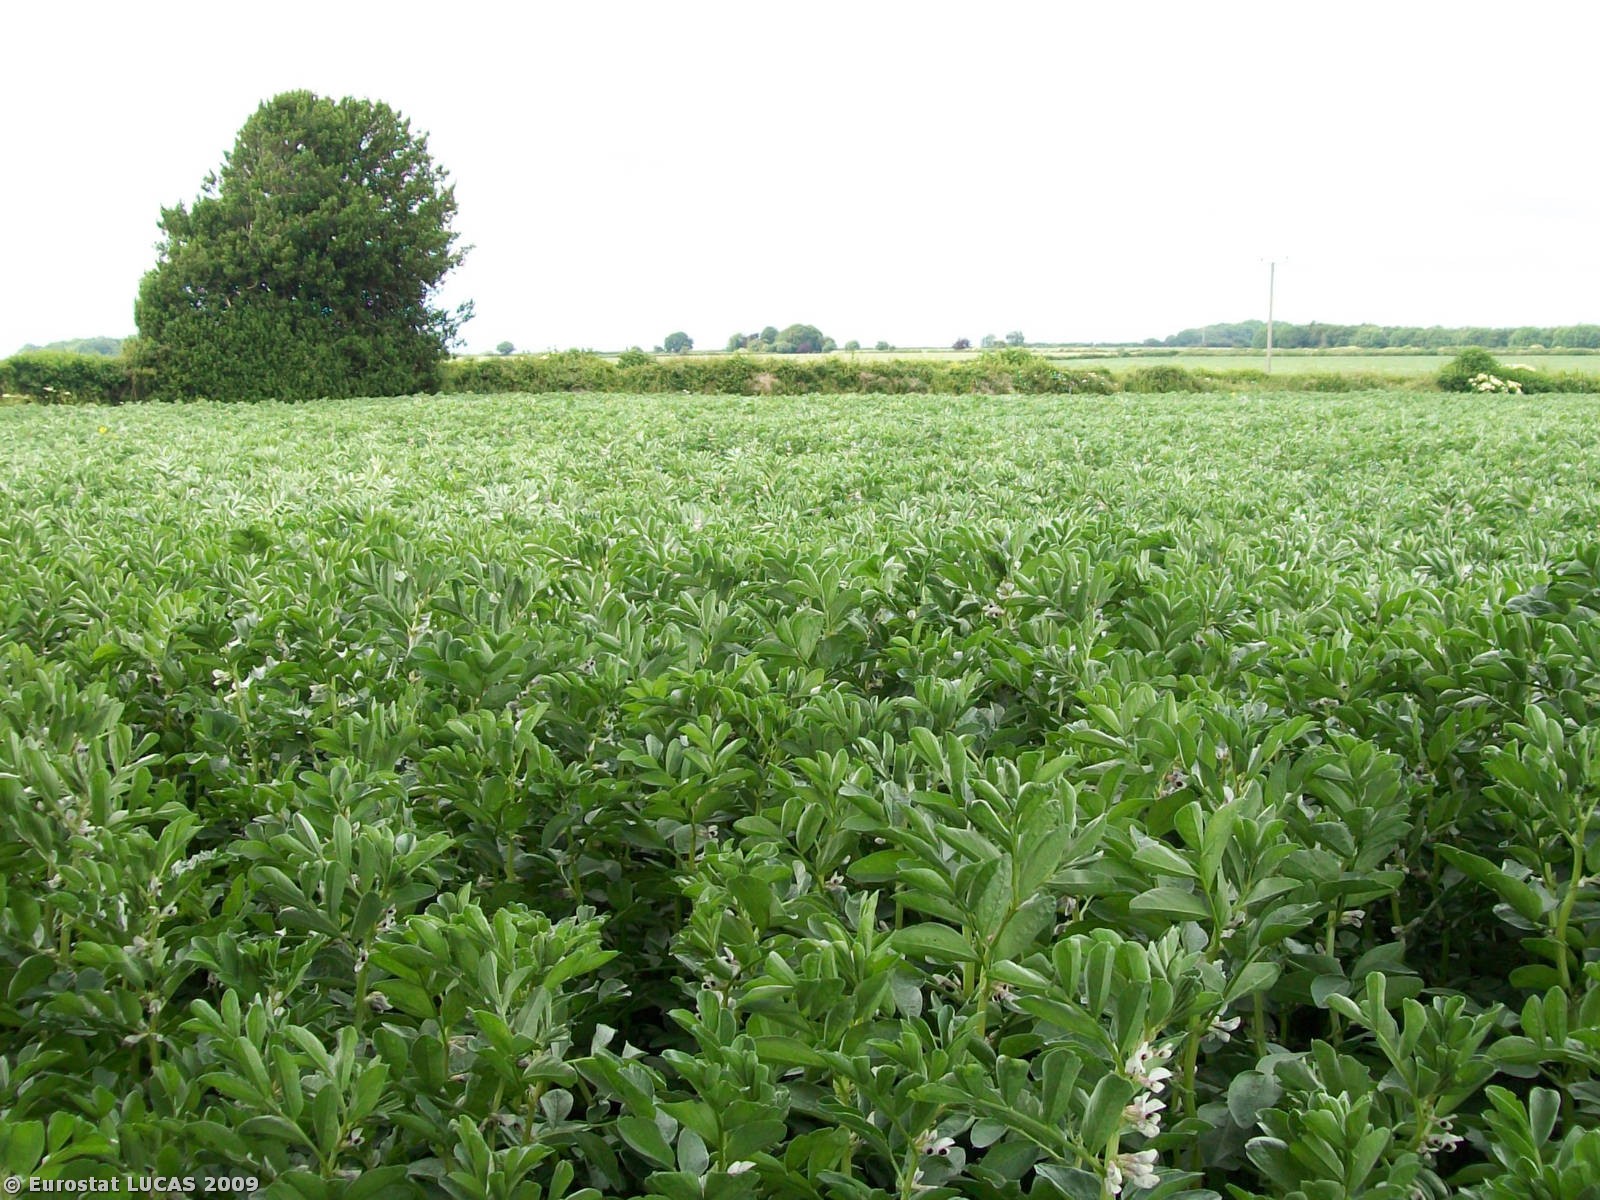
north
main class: Cropland
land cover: Dry pulses
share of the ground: > 75 %
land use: Agriculture (excluding fallow land and kitchen gardens)
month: June
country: GB
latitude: 50.8062
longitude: -2.1364
